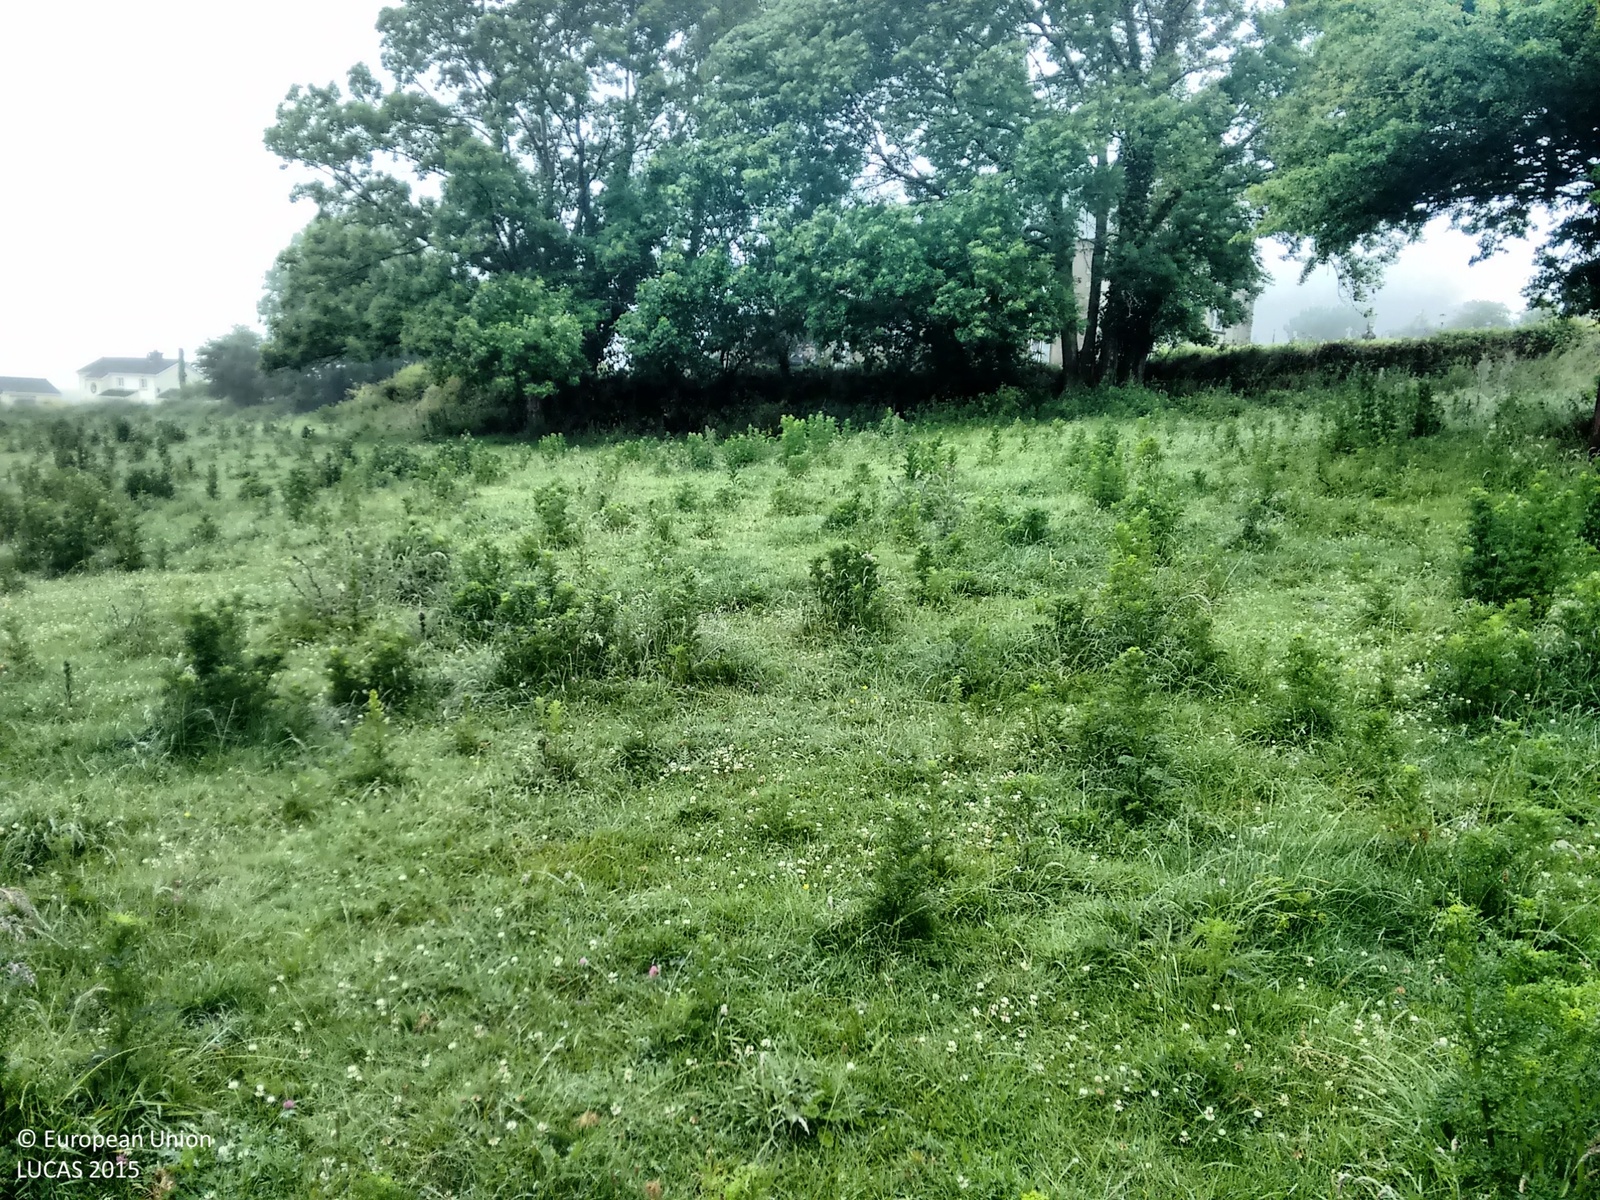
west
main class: Grassland
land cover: Grassland without tree/shrub cover
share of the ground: > 75 %
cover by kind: herbaceous plants 100 %
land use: Agriculture (excluding fallow land and kitchen gardens)
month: June
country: IE
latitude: 52.3823
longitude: -7.2974
